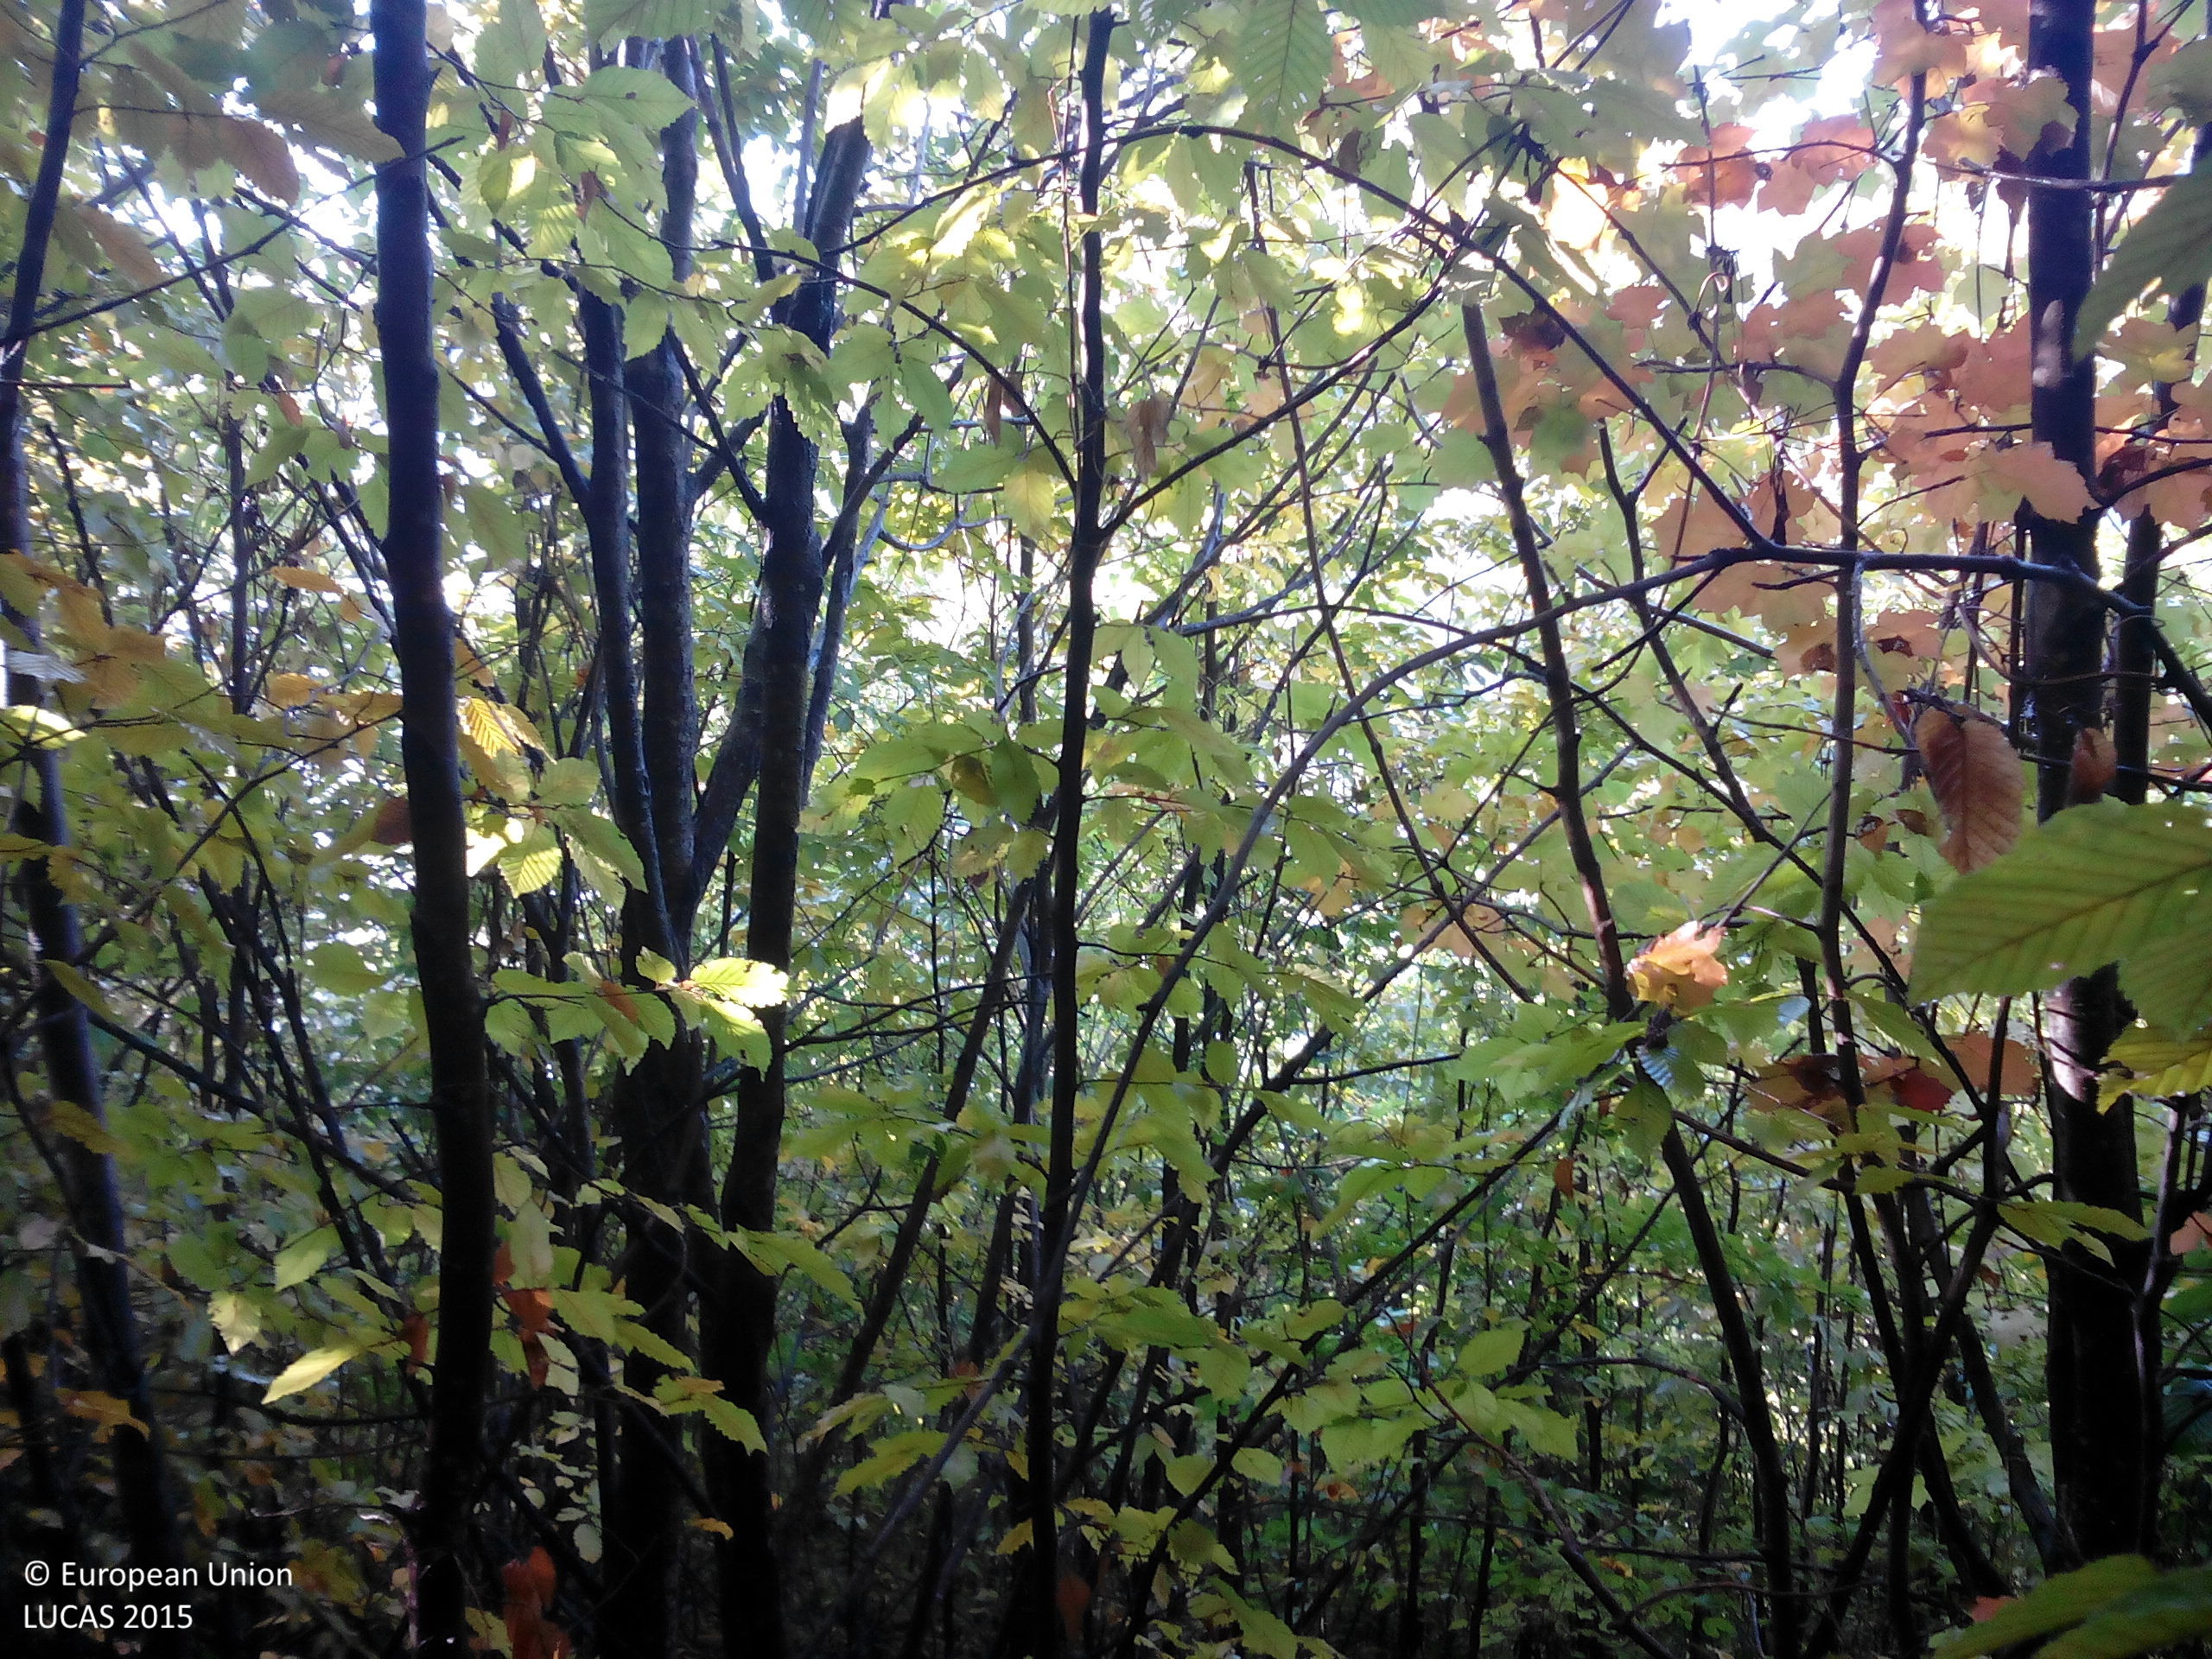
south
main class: Woodland
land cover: Broadleaved woodland
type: beech forest
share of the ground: > 75 %
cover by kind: broadleaved forest trees 95 %, shrubs 5 %
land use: Forestry
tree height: < 5 m
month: October
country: BG
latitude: 42.8174
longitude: 24.7230
